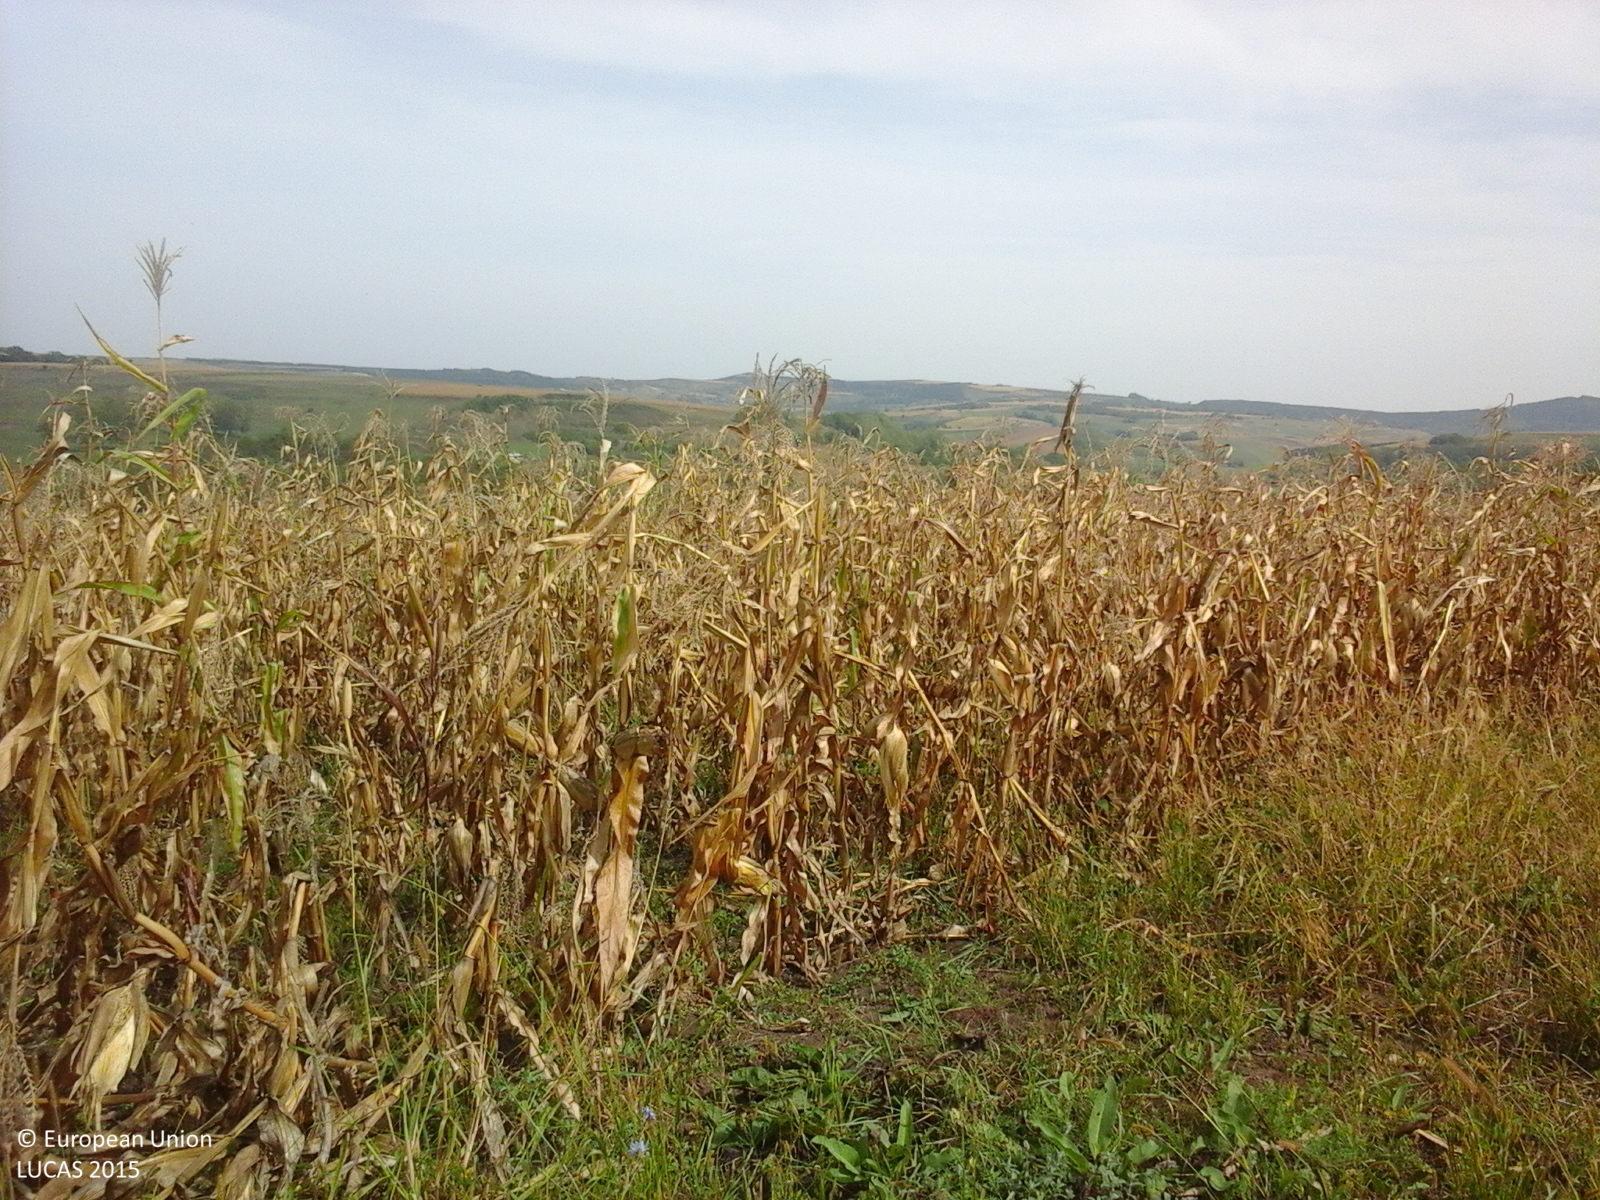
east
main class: Cropland
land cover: Maize
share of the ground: > 75 %
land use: Agriculture (excluding fallow land and kitchen gardens)
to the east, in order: Maize; Other fruit trees and berries; Artificial constructions in urban areas; Broadleaved woodland; Ditches and canals; Broadleaved woodland
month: September
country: RO
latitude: 46.8478
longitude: 24.1535
